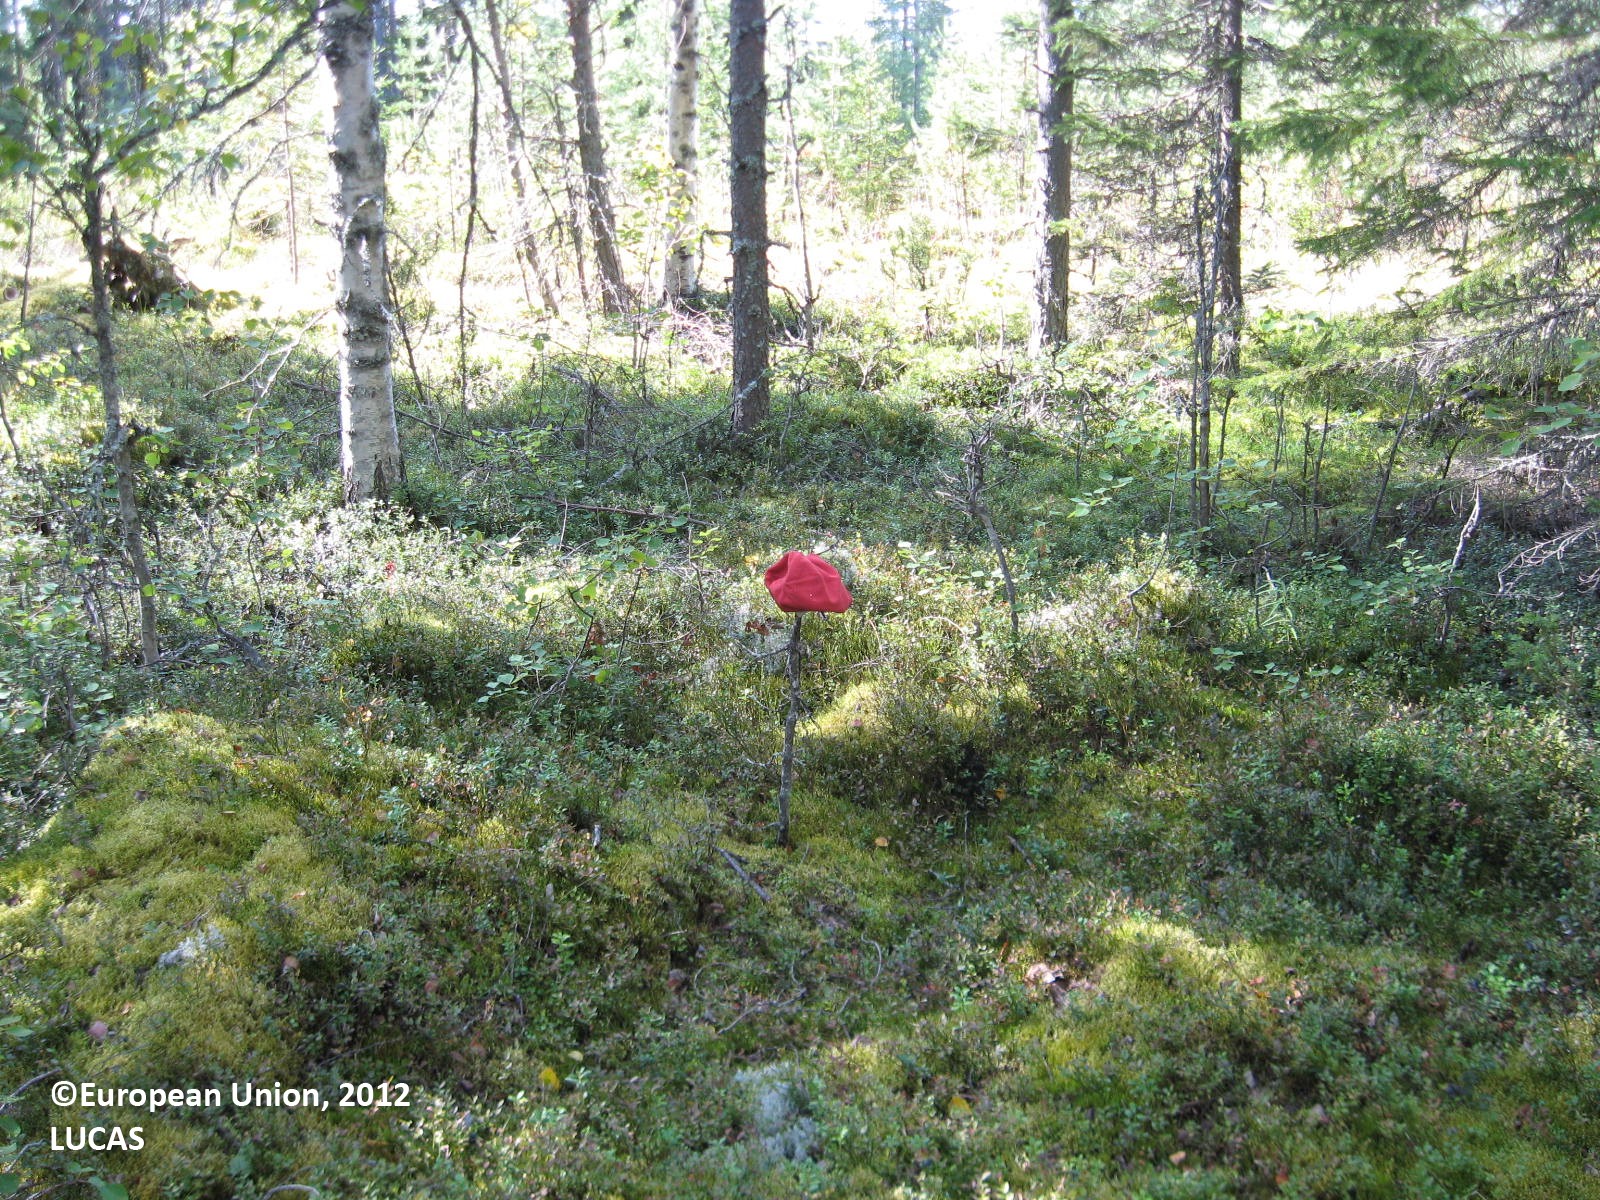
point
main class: Woodland
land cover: Pine dominated coniferous woodland
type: boreal forest
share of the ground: > 75 %
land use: Forestry
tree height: > 5 m
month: August
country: FI
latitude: 63.6454
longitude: 29.7179
